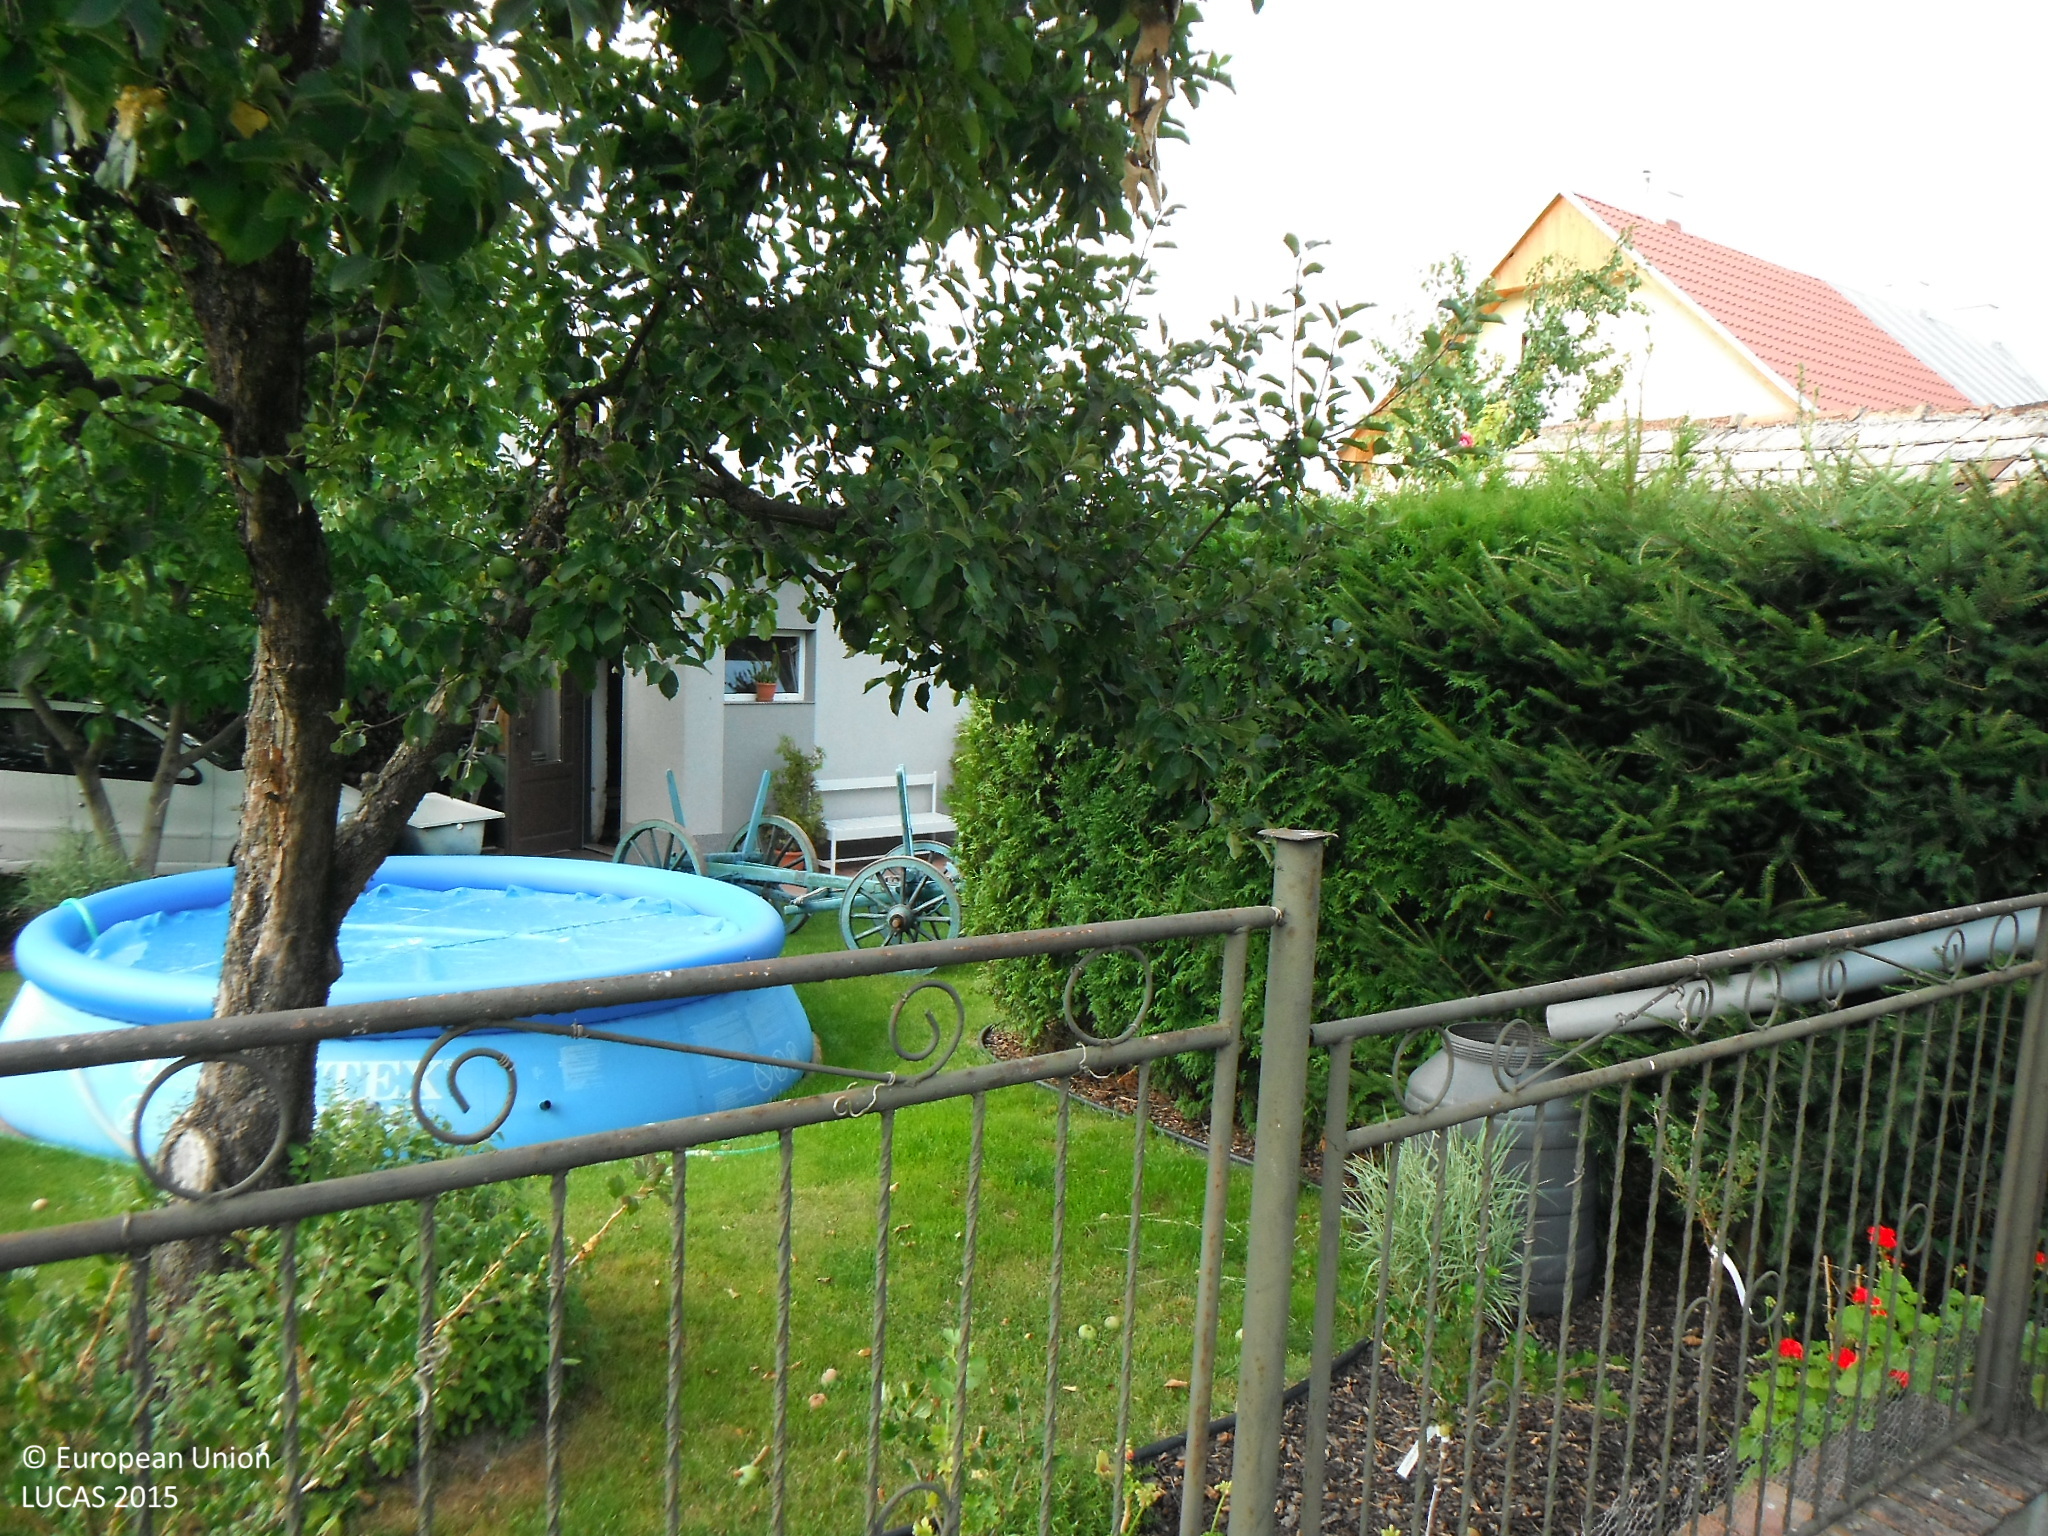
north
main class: Cropland
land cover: Apple fruit
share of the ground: 25 - 50 %
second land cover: Grassland without tree/shrub cover
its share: 50 - 75 %
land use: Kitchen garden
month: July
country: SK
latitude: 49.2994
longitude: 21.4206
